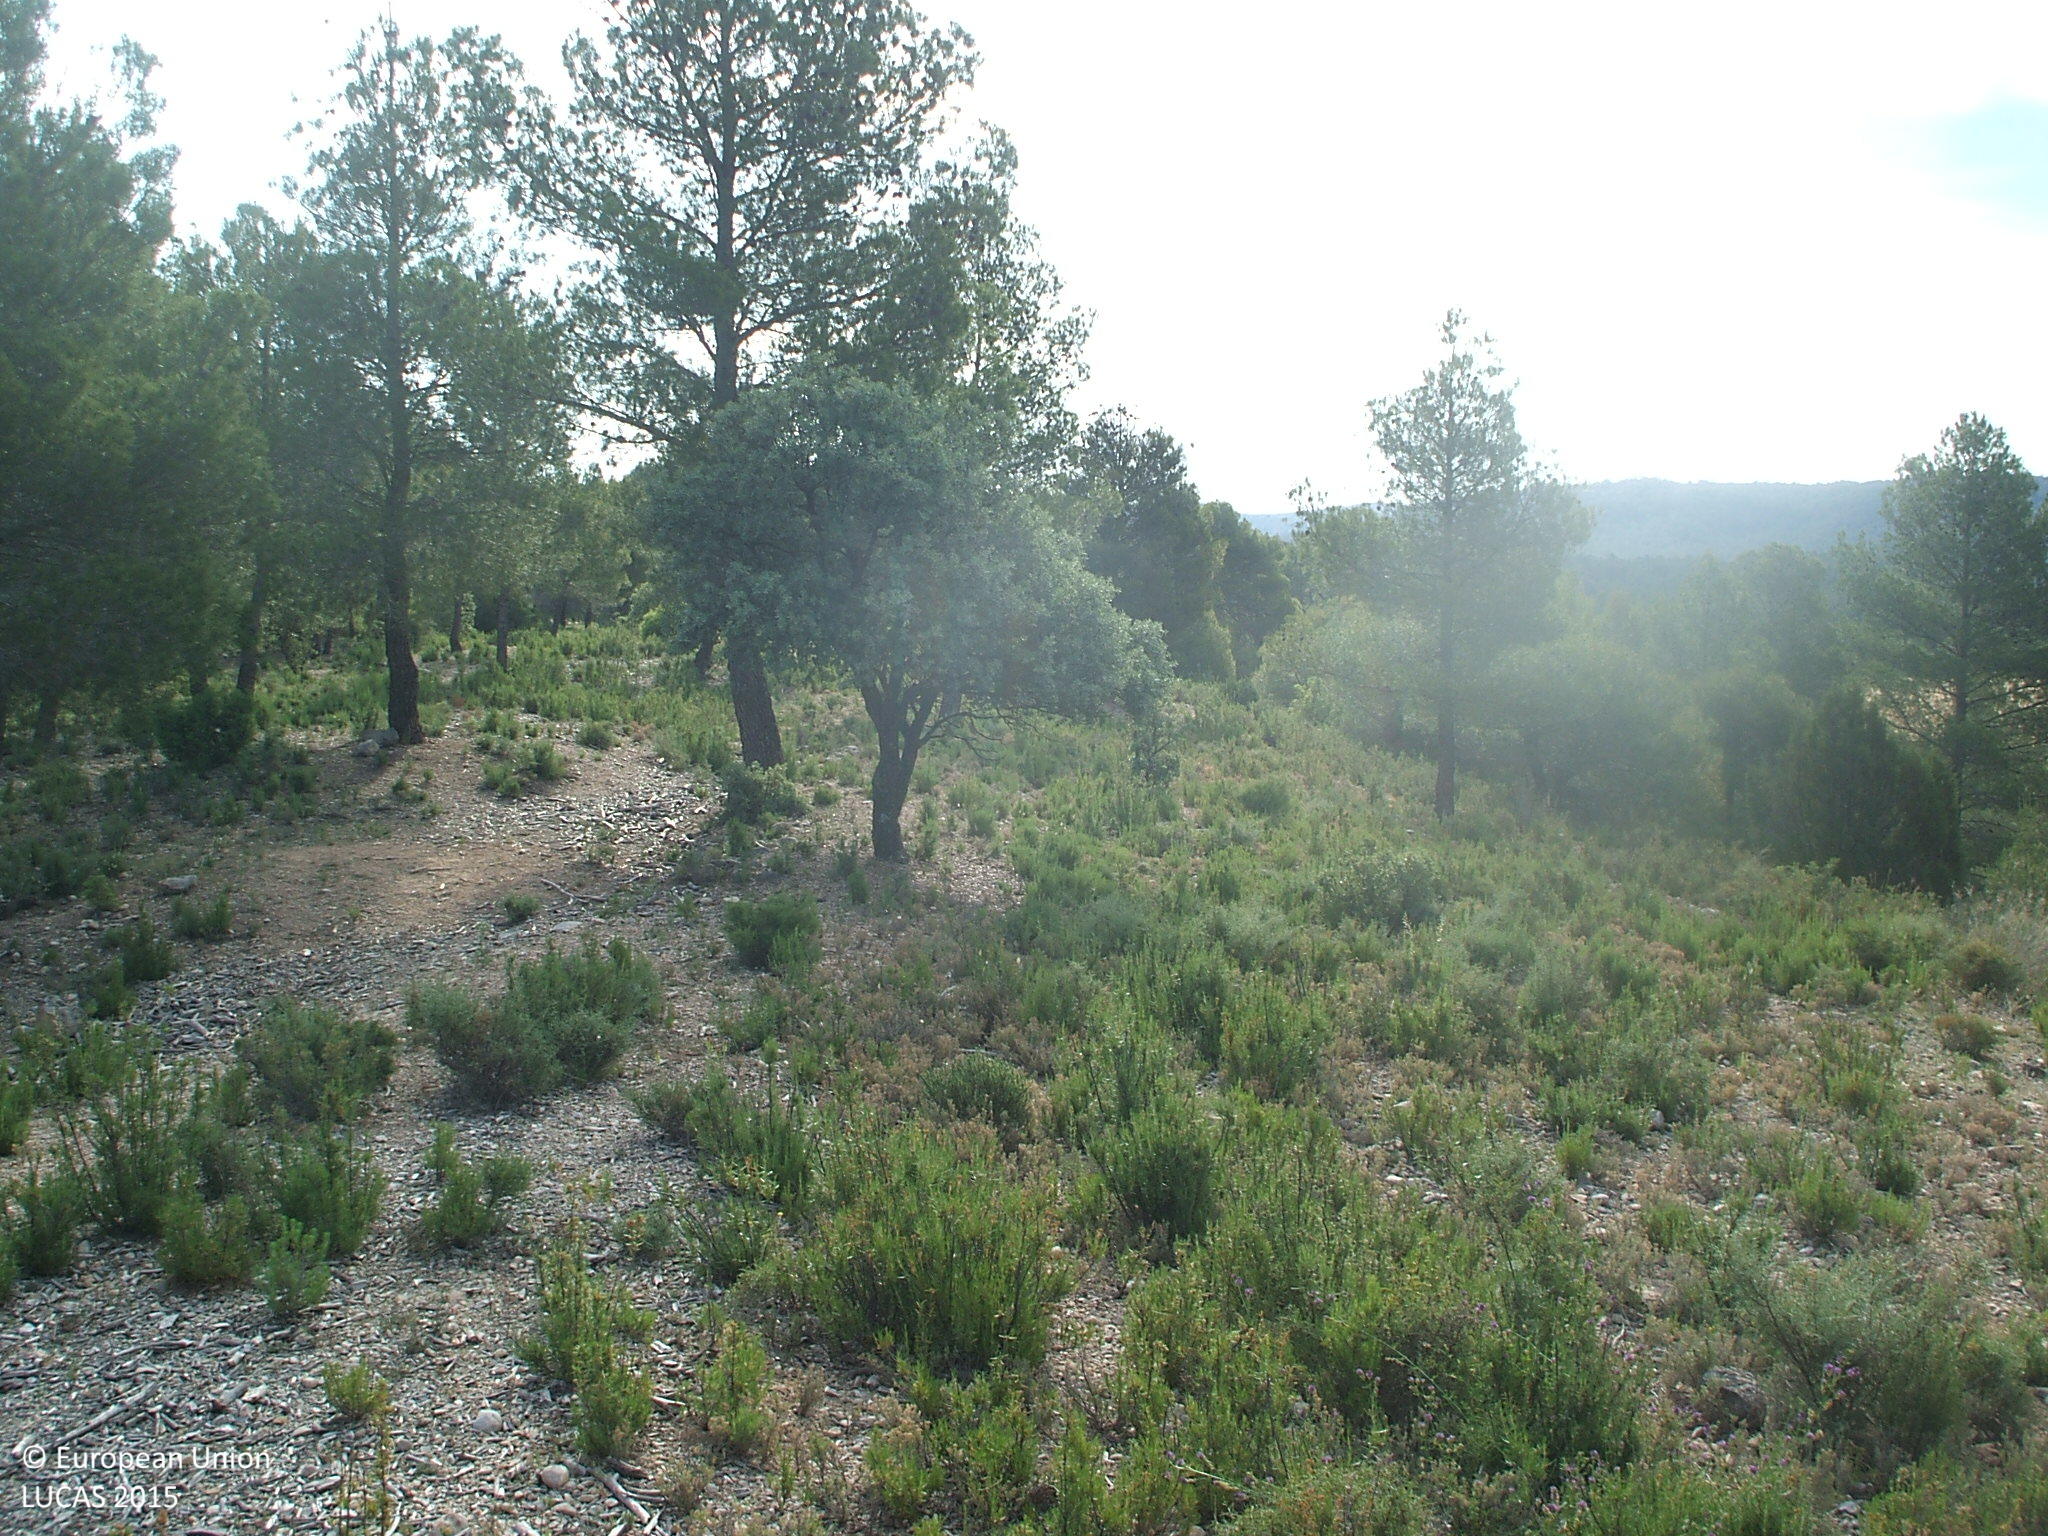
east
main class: Woodland
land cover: Pine dominated coniferous woodland
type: coniferous forest of the mediterranean region
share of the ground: 25 - 50 %
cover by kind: shrubs 40 %, coniferous forest trees 35 %, consolidated bare surface 25 %
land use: Semi-natural and natural areas not in use
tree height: > 5 m
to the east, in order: Pine dominated coniferous woodland; Pine dominated mixed woodland
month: June
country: ES
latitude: 40.7440
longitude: -0.3009
